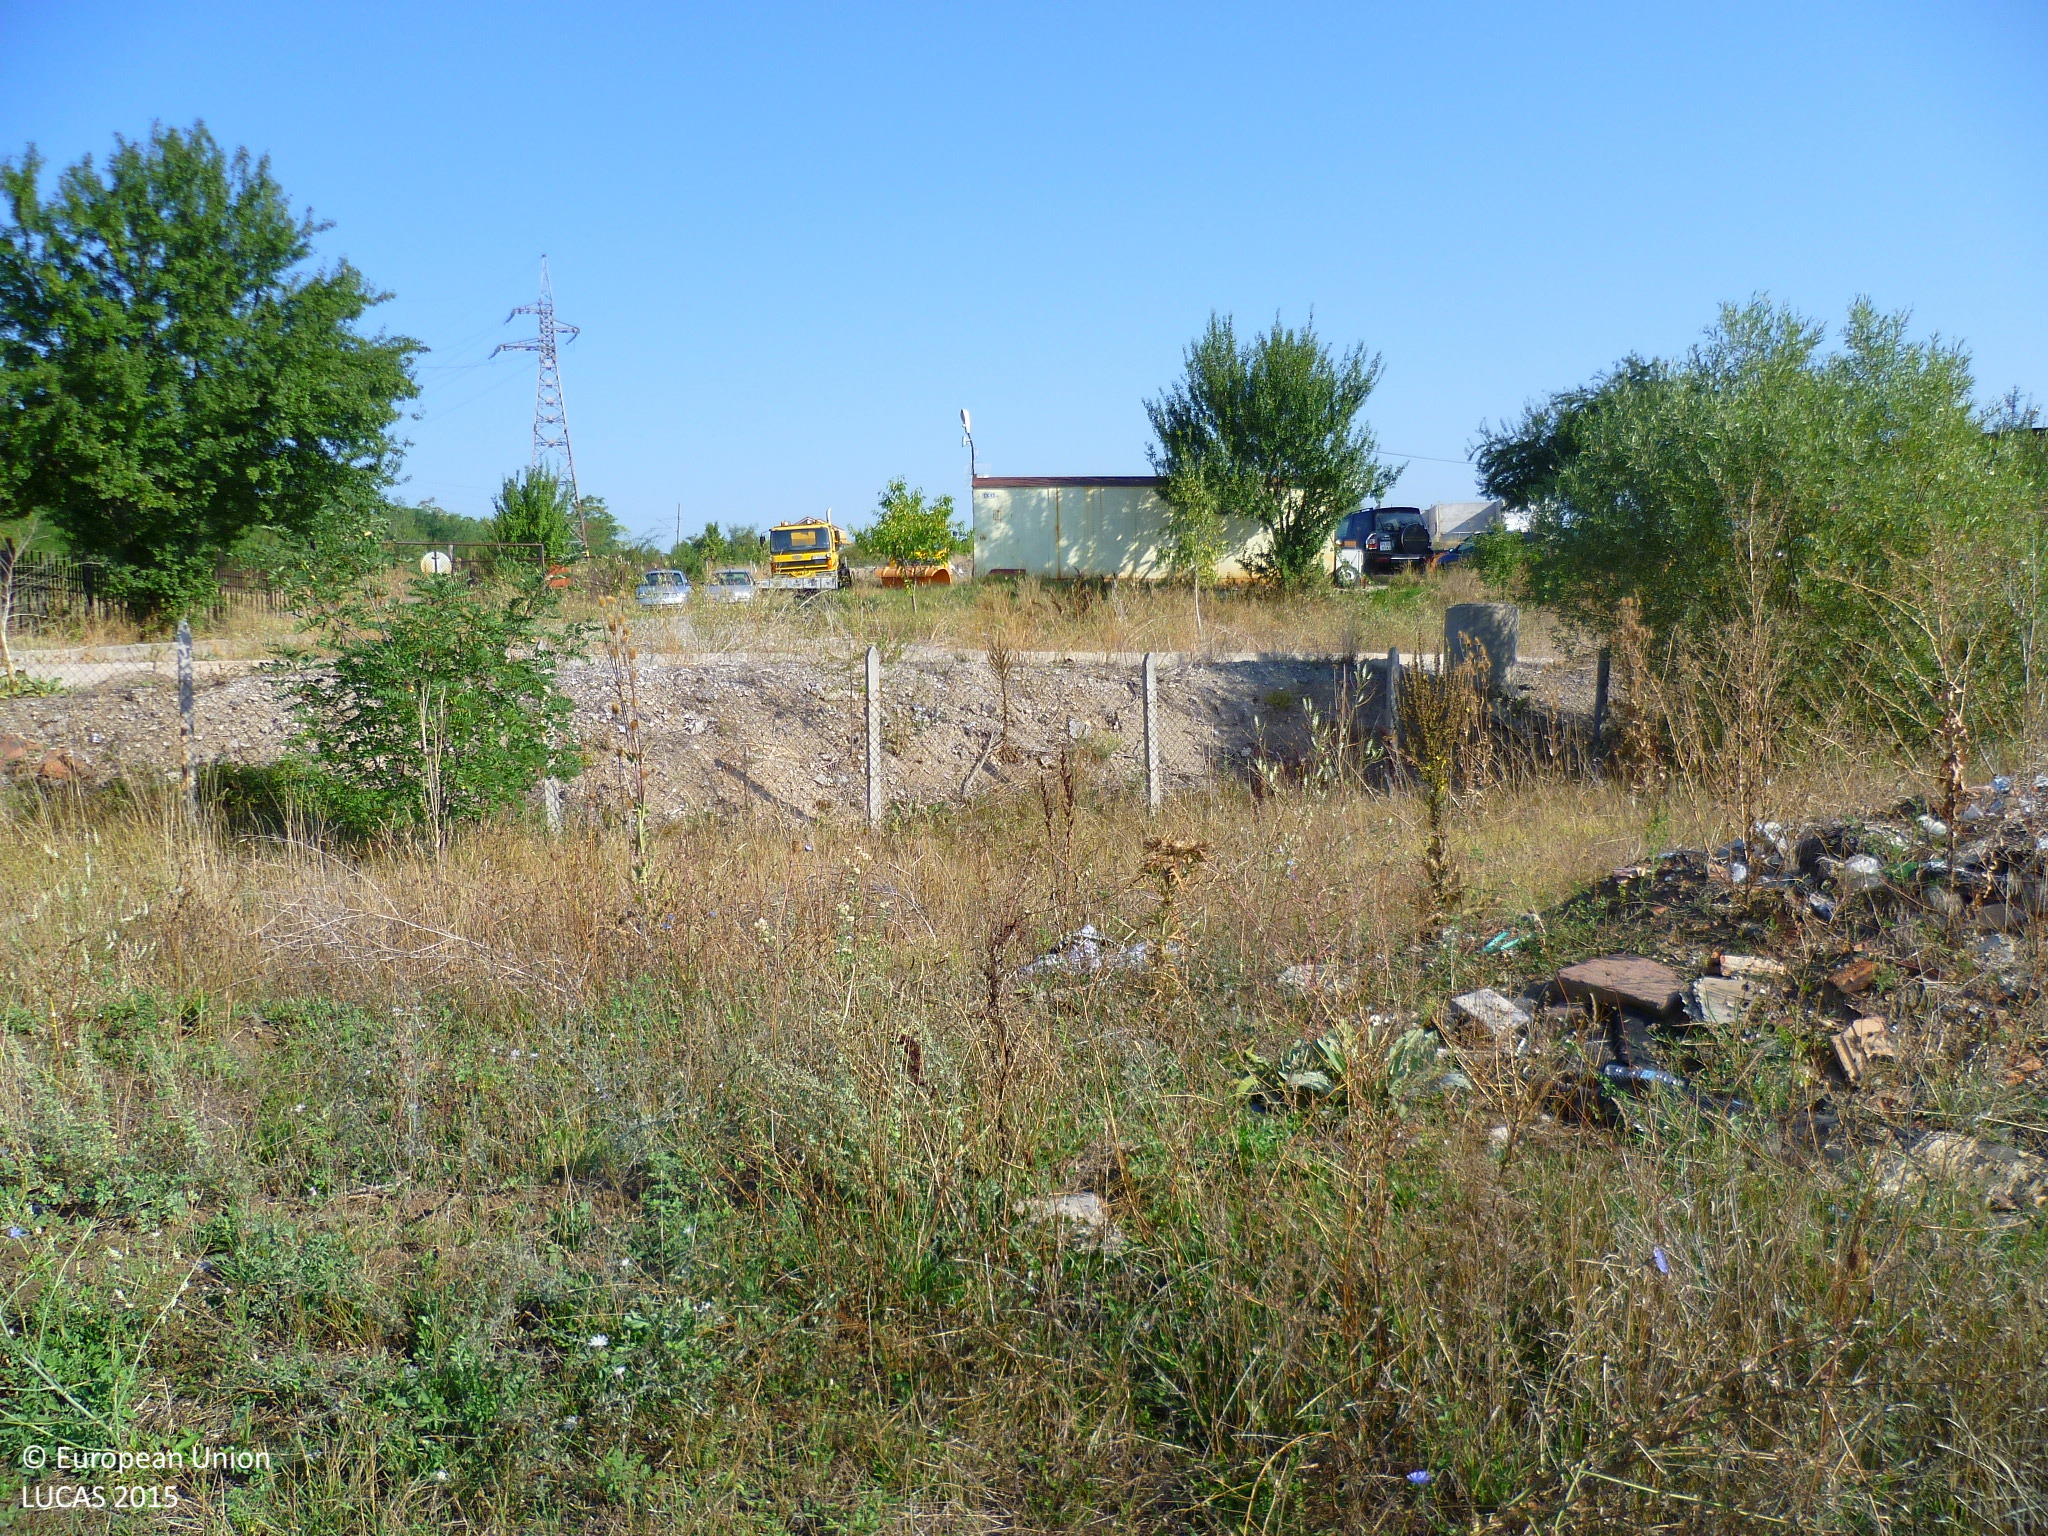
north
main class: Grassland
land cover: Grassland without tree/shrub cover
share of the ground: > 75 %
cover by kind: herbaceous plants 80 %, unconsolidated bare surface 20 %
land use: Abandoned areas
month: September
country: BG
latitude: 42.6291
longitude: 23.0403
